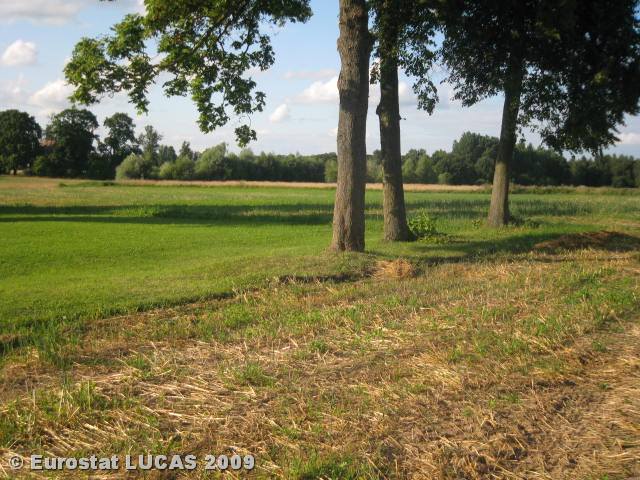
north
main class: Grassland
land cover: Grassland without tree/shrub cover
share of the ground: 25 - 50 %
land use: Fallow land
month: August
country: LT
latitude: 55.3079
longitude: 23.6468
